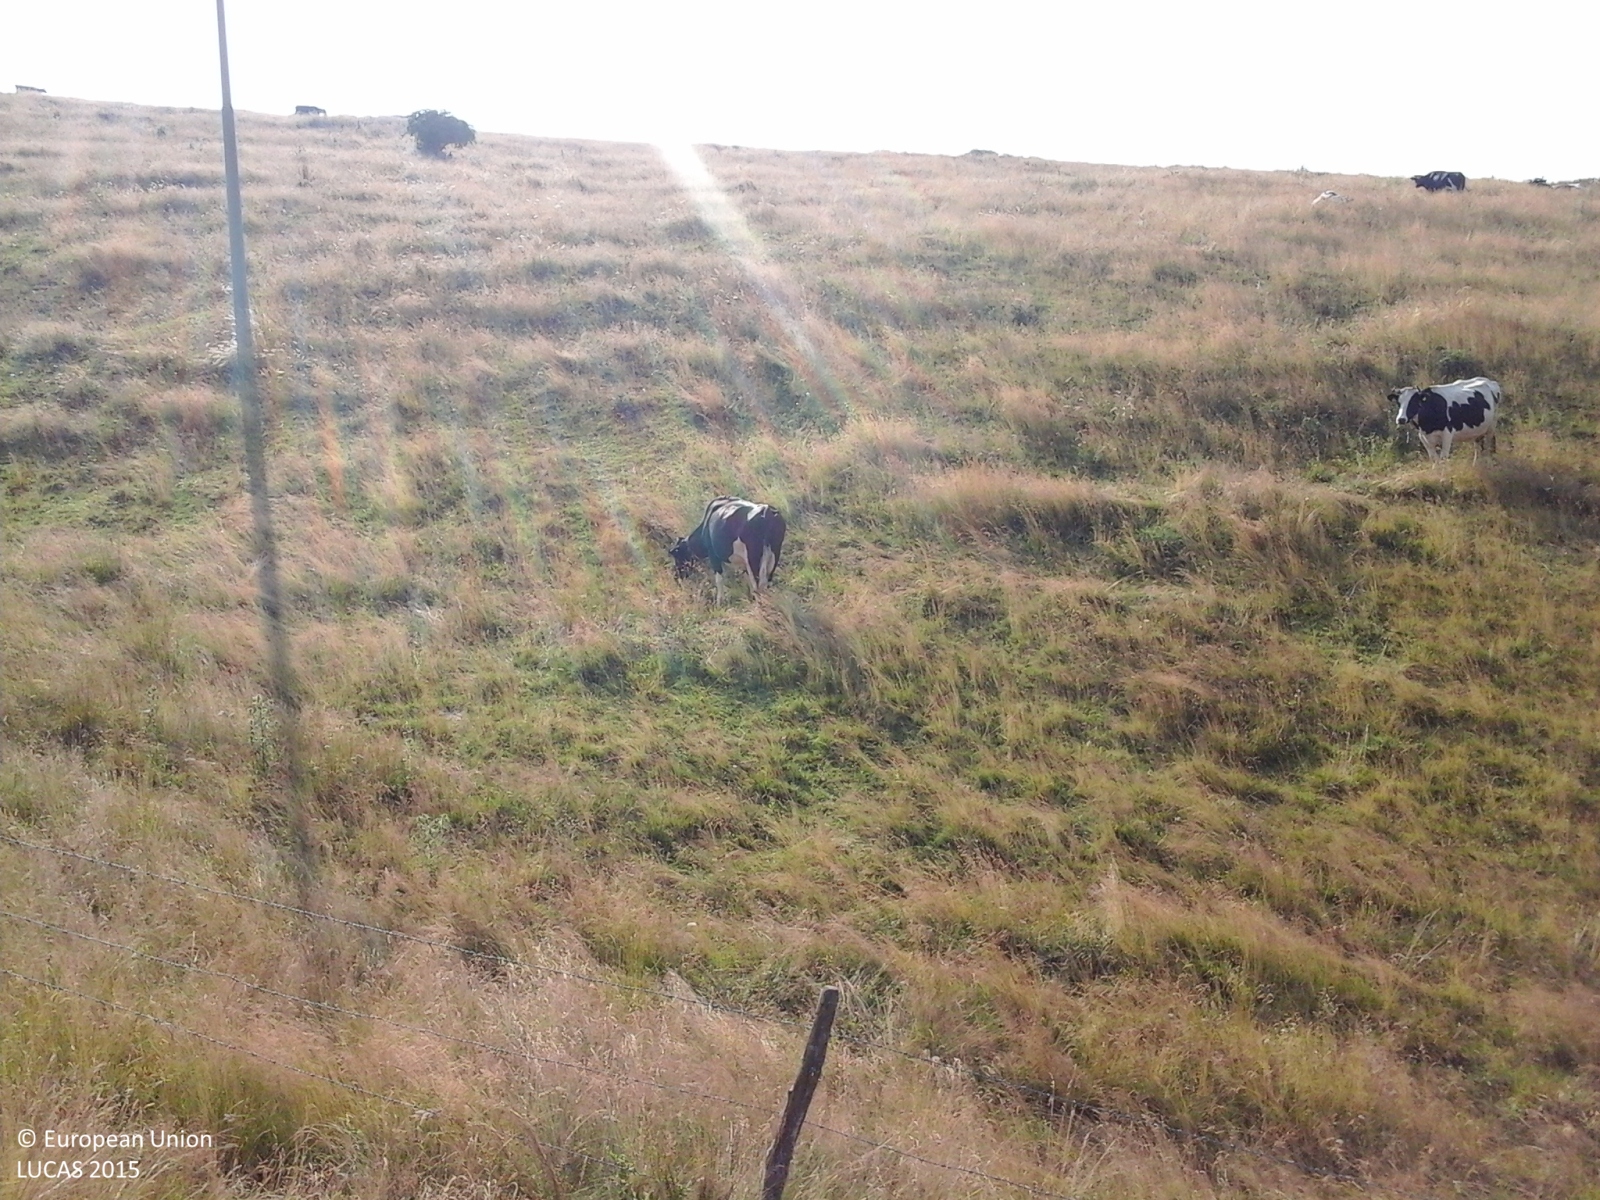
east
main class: Grassland
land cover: Grassland without tree/shrub cover
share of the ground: > 75 %
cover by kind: herbaceous plants 100 %
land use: Agriculture (excluding fallow land and kitchen gardens)
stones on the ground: 10 - 25 %
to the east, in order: Grassland without tree/shrub cover; Fences; Grassland without tree/shrub cover; Electric lines; Grassland without tree/shrub cover; Paved roads, cycling and walking lanes; Grass margins; Lines of trees; Fences; Grassland without tree/shrub cover; Electric lines; Grassland without tree/shrub cover
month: July
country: IT
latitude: 45.6430
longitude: 11.0888
